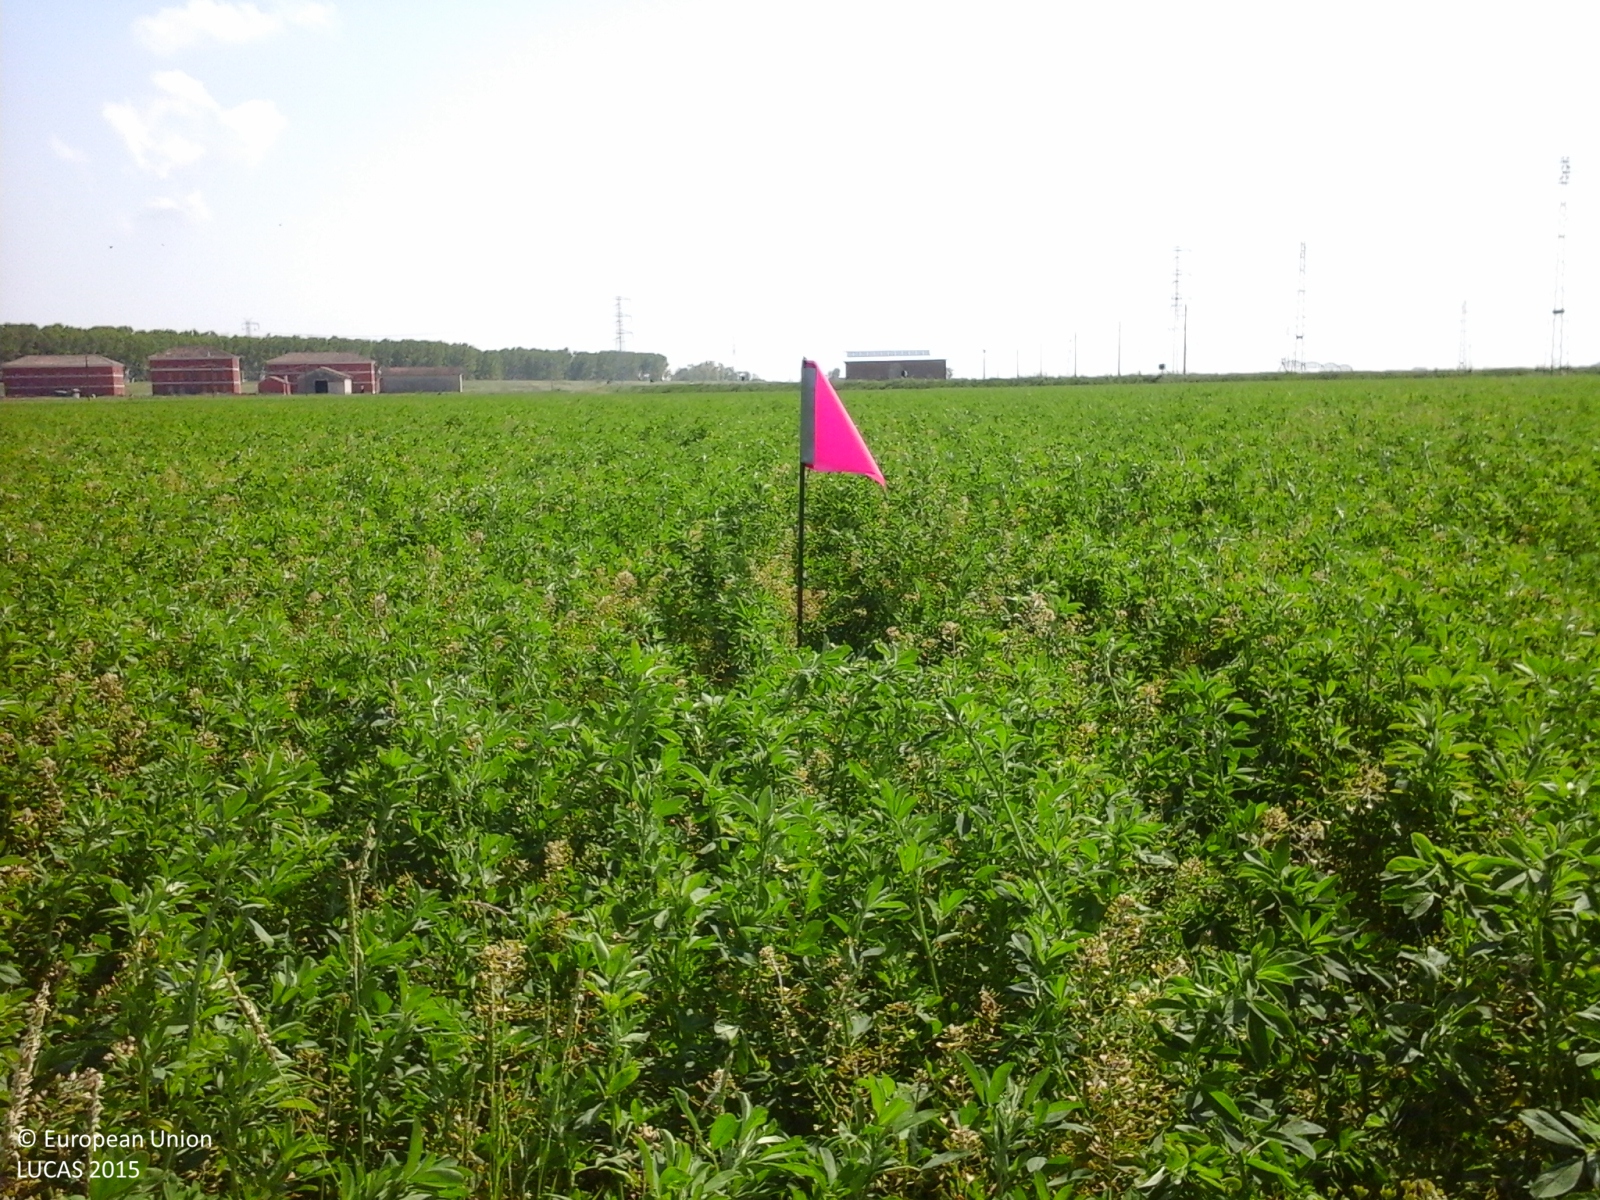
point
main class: Cropland
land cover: Lucerne
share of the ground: > 75 %
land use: Agriculture (excluding fallow land and kitchen gardens)
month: April
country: IT
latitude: 44.9201
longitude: 12.3140
